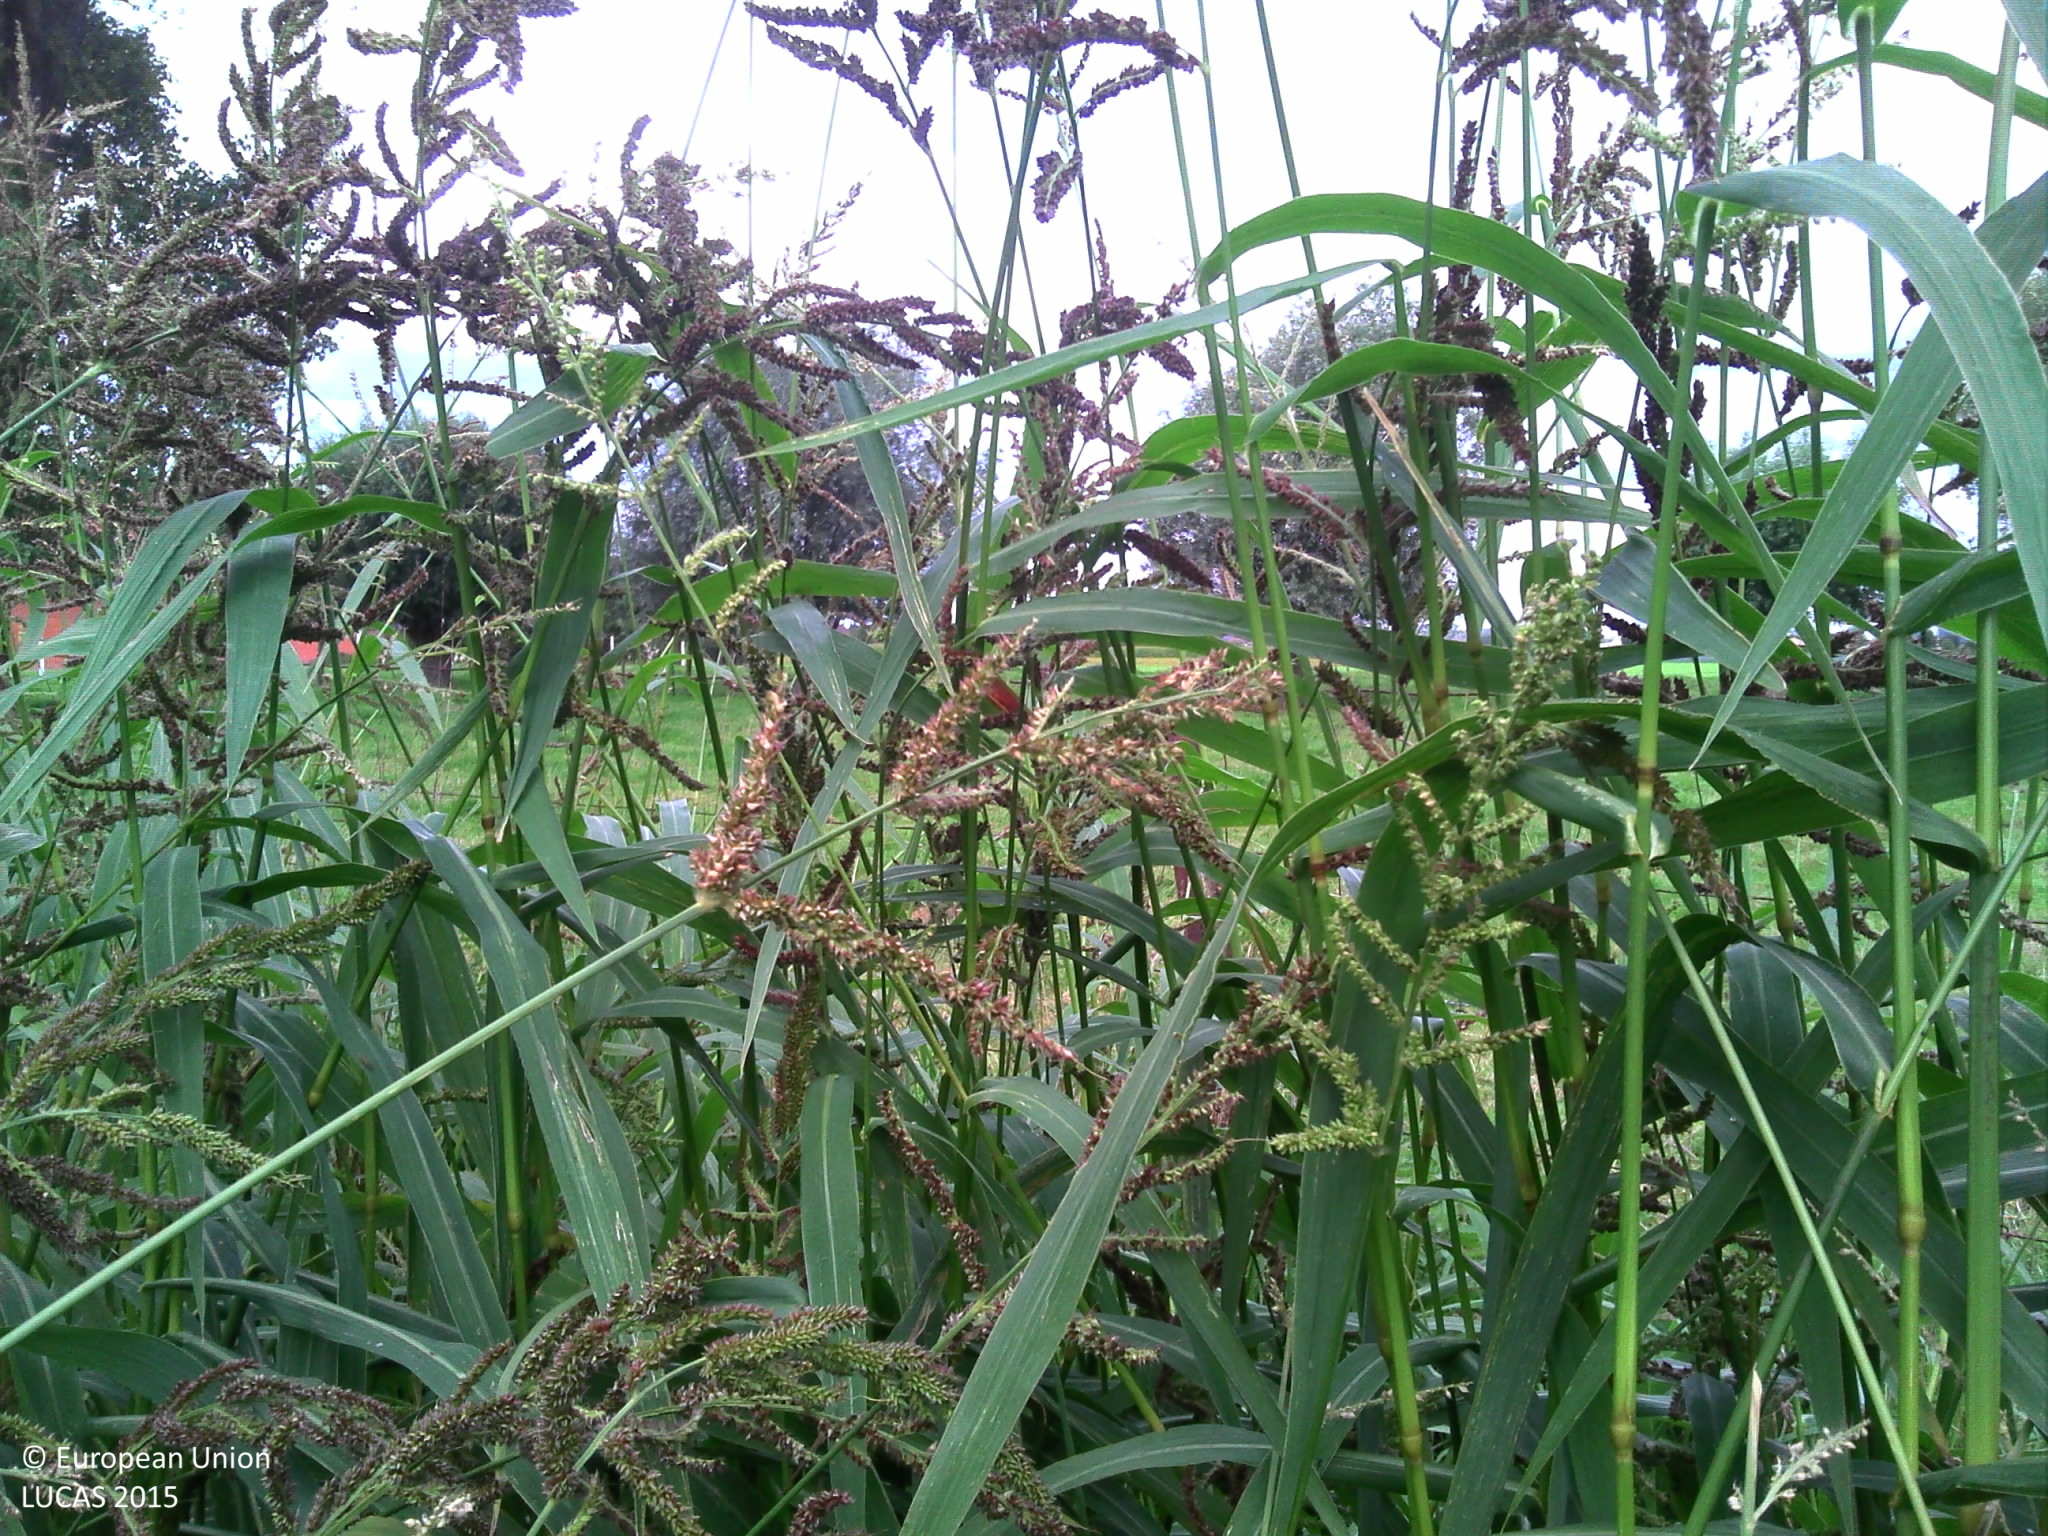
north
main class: Cropland
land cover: Maize
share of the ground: > 75 %
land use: Agriculture (excluding fallow land and kitchen gardens)
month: September
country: BE
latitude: 50.9084
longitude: 2.7212
